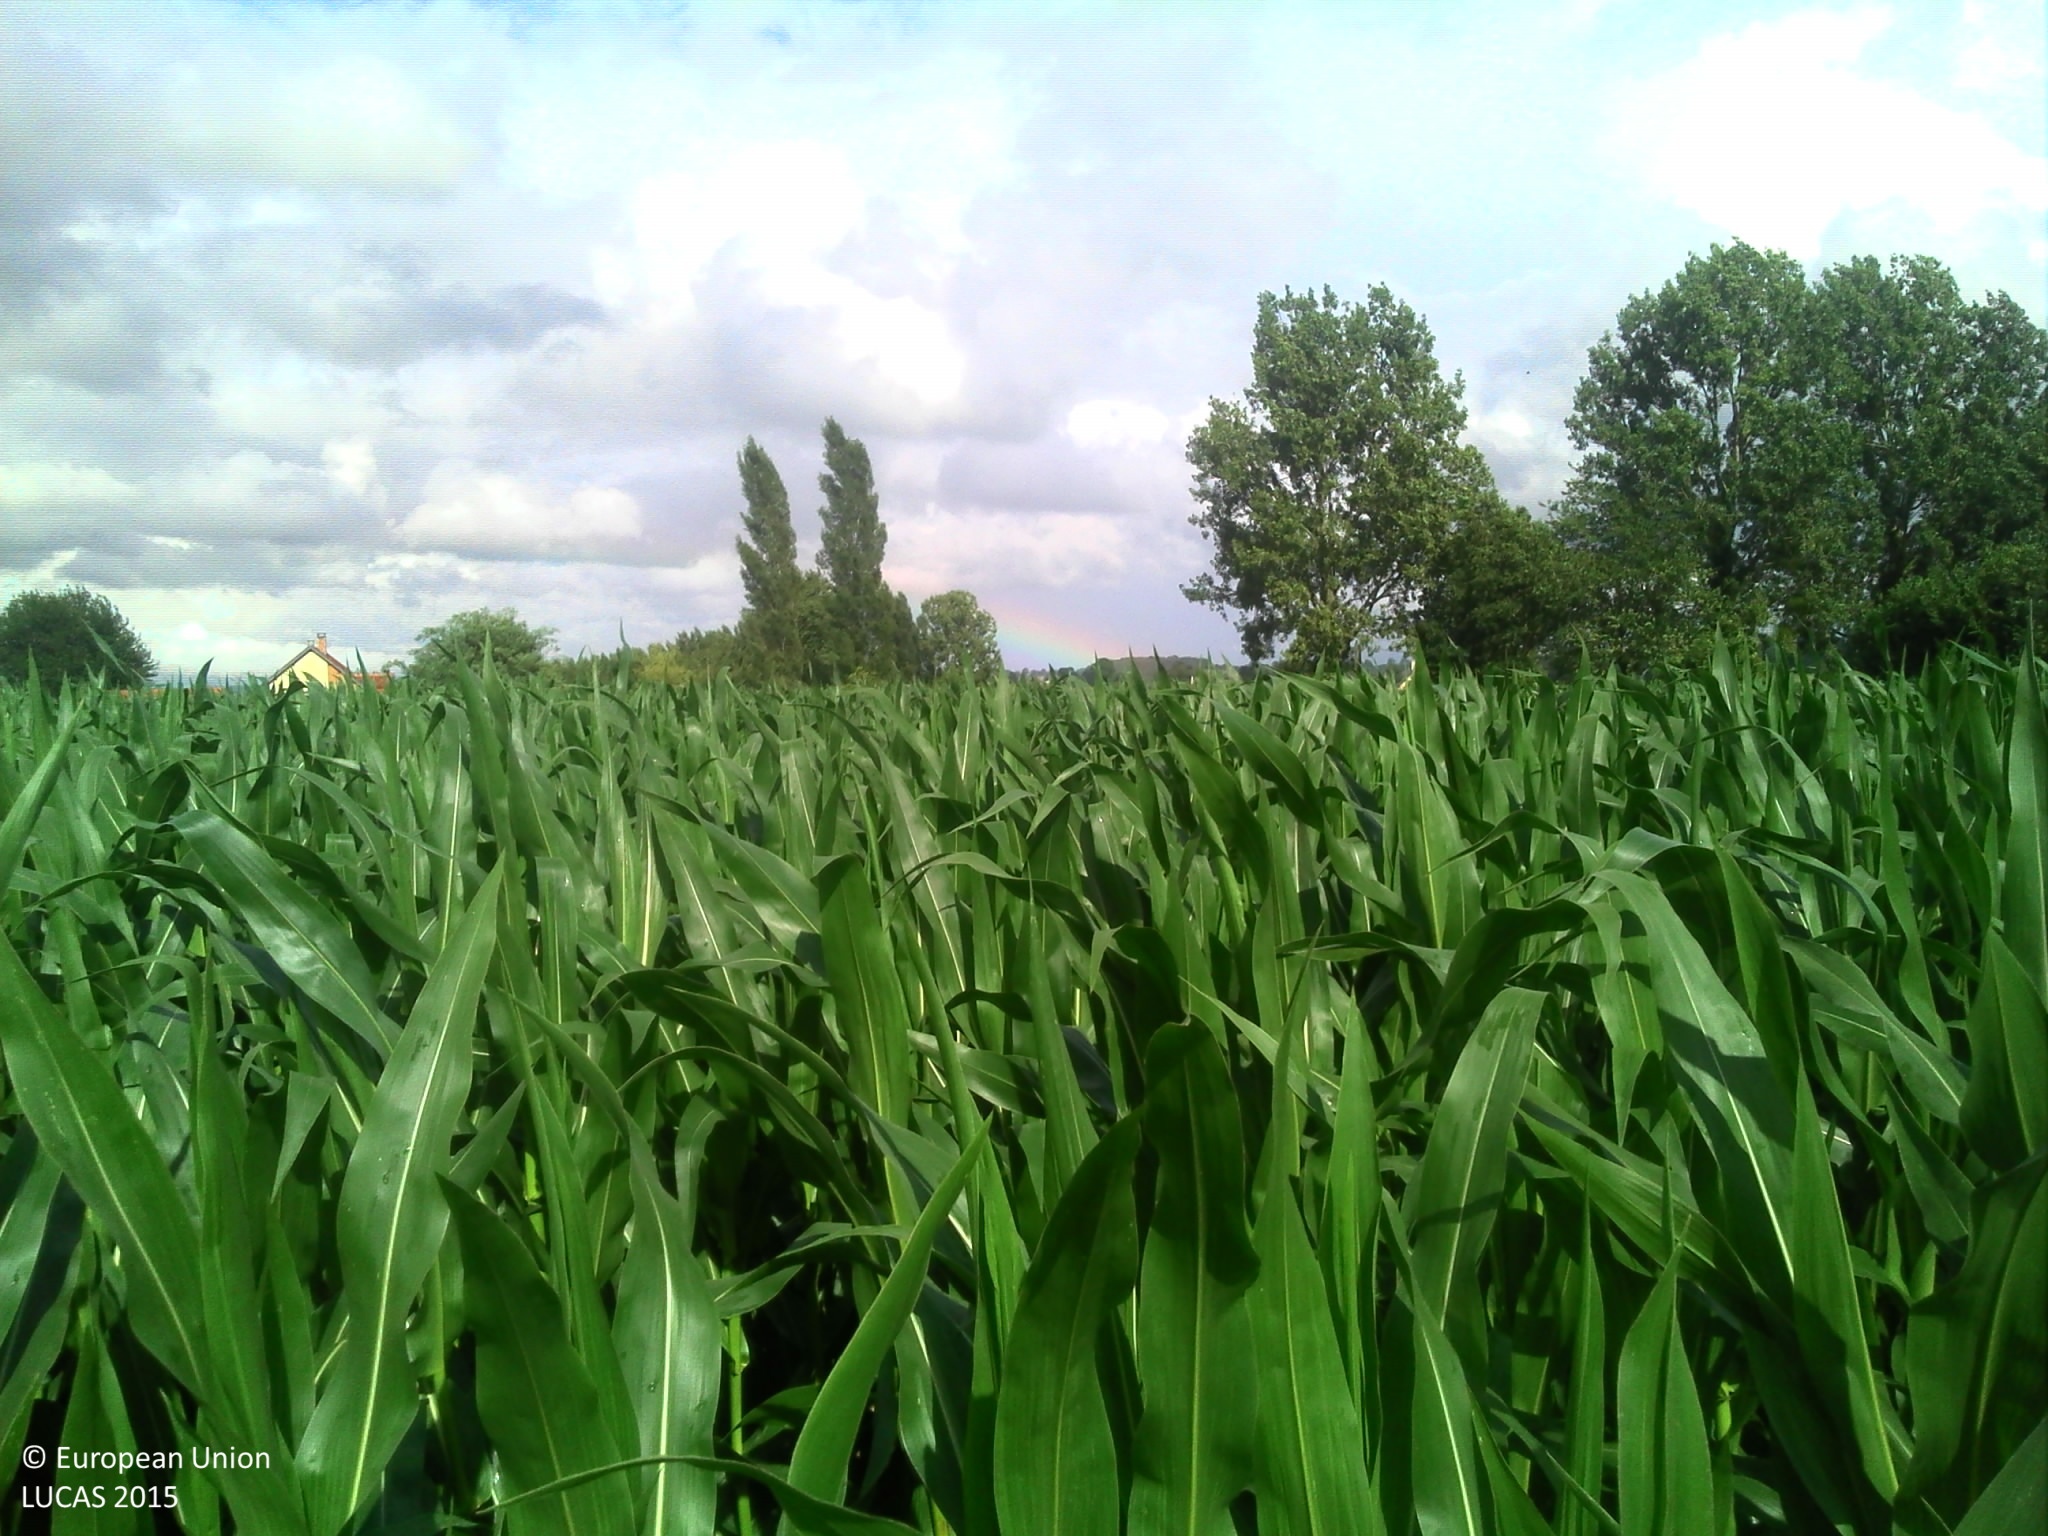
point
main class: Cropland
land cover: Maize
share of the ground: > 75 %
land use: Agriculture (excluding fallow land and kitchen gardens)
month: July
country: FR
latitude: 48.7316
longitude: -1.2887
